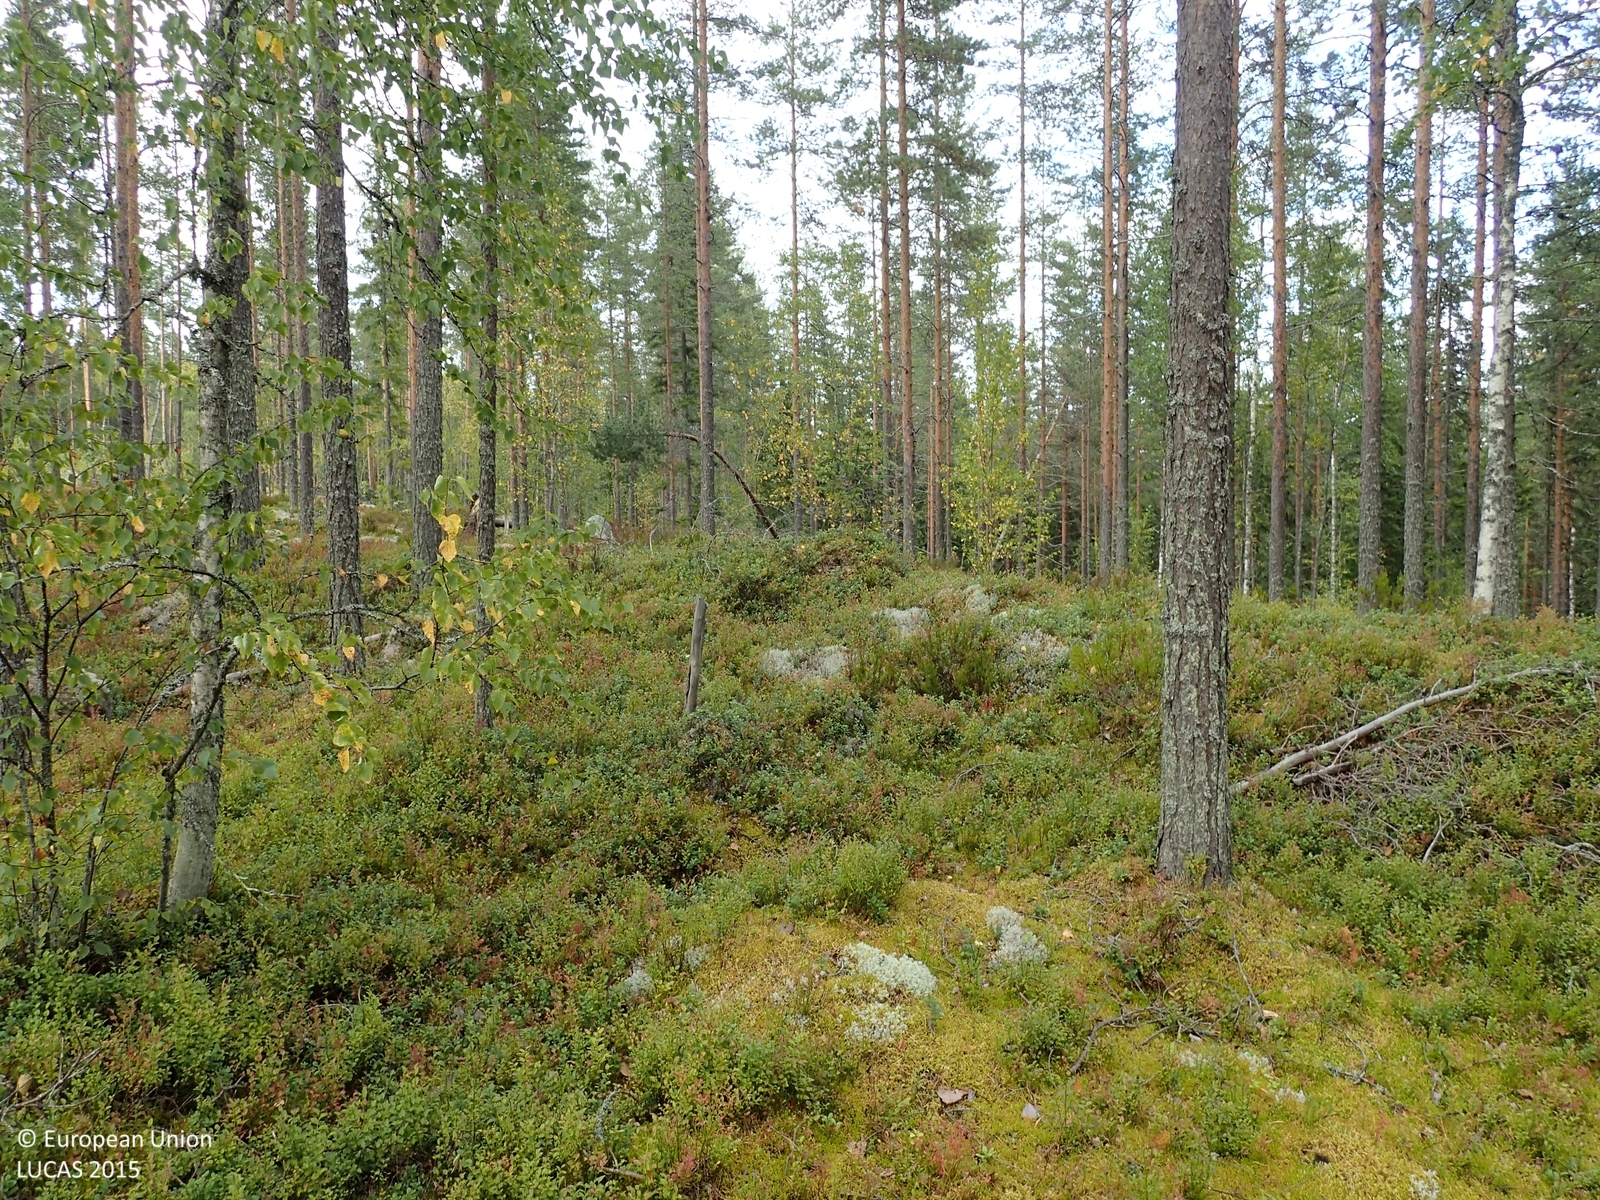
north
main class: Woodland
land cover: Pine dominated mixed woodland
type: boreal forest
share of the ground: 50 - 75 %
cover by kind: coniferous forest trees 45 %, shrubs 30 %, broadleaved forest trees 15 %, lichens and mosses 10 %
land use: Forestry
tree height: > 5 m
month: September
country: FI
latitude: 63.1809
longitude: 25.9087
